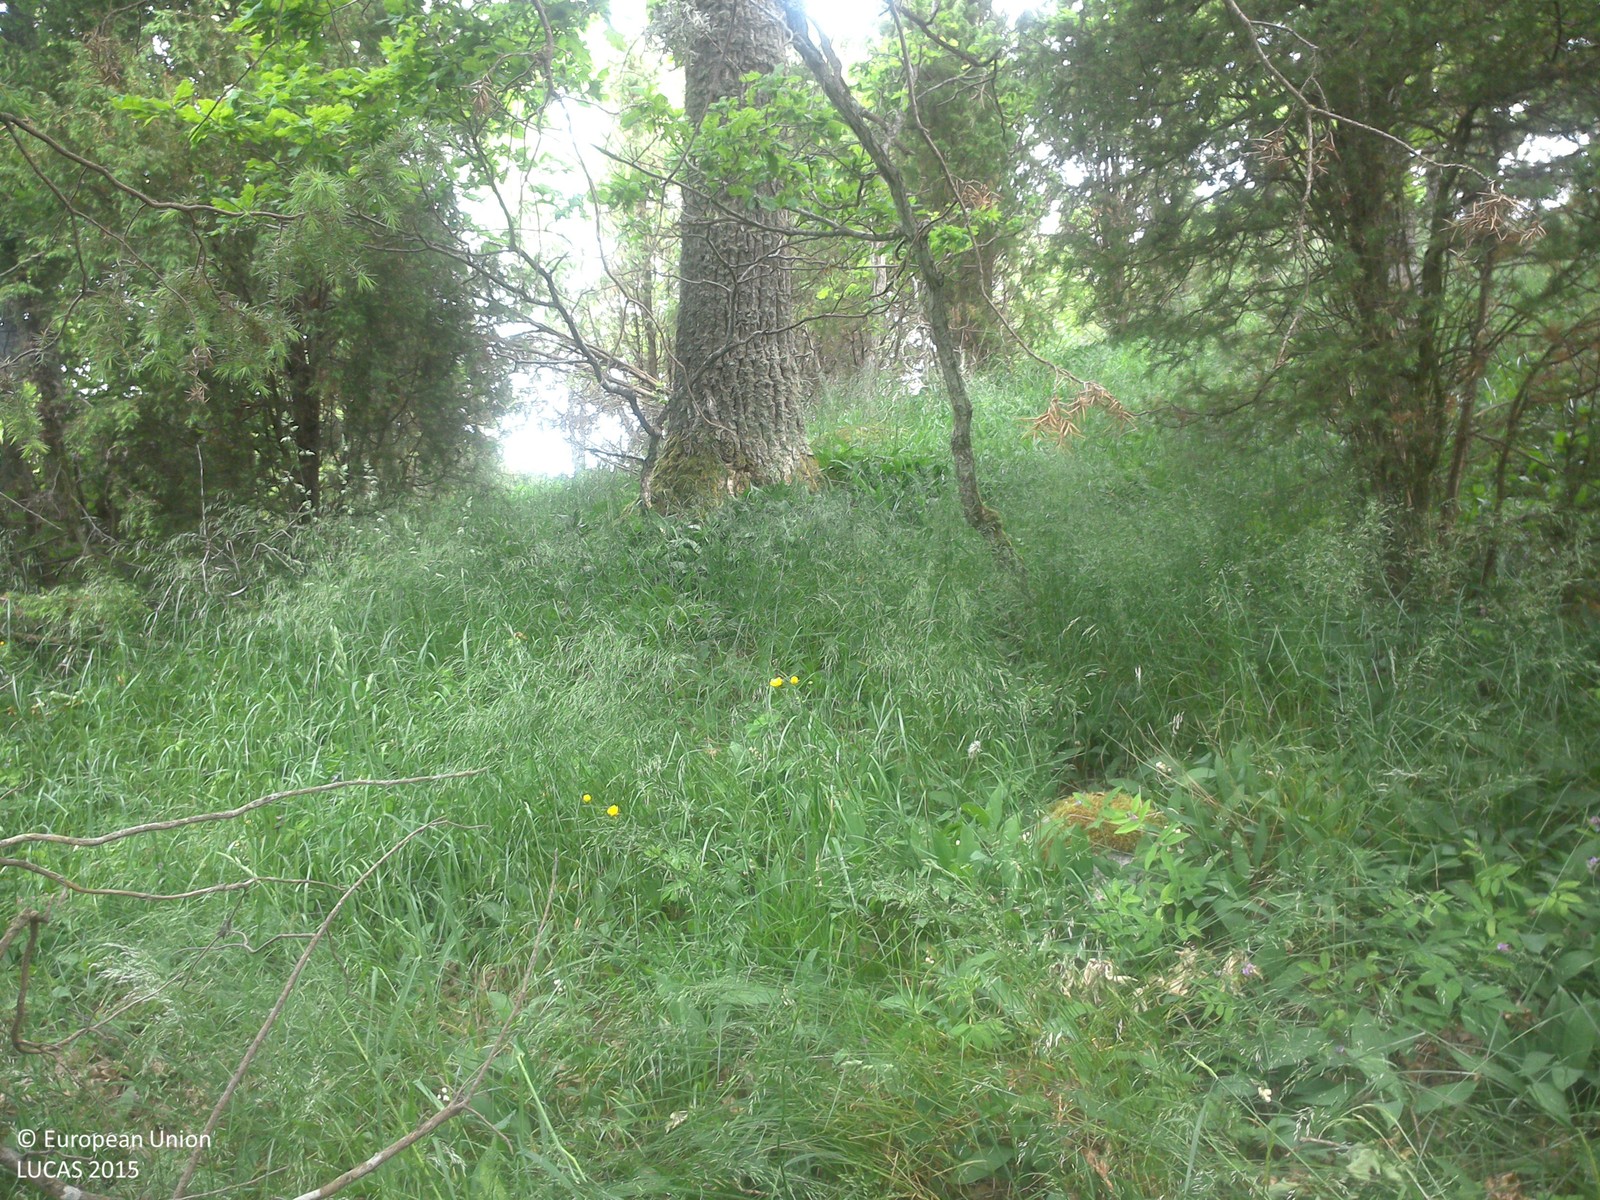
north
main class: Woodland
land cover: Broadleaved woodland
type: boreal forest
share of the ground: > 75 %
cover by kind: broadleaved forest trees 75 %, herbaceous plants 25 %
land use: Forestry
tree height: > 5 m
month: June
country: SE
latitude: 58.1519
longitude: 15.7215
